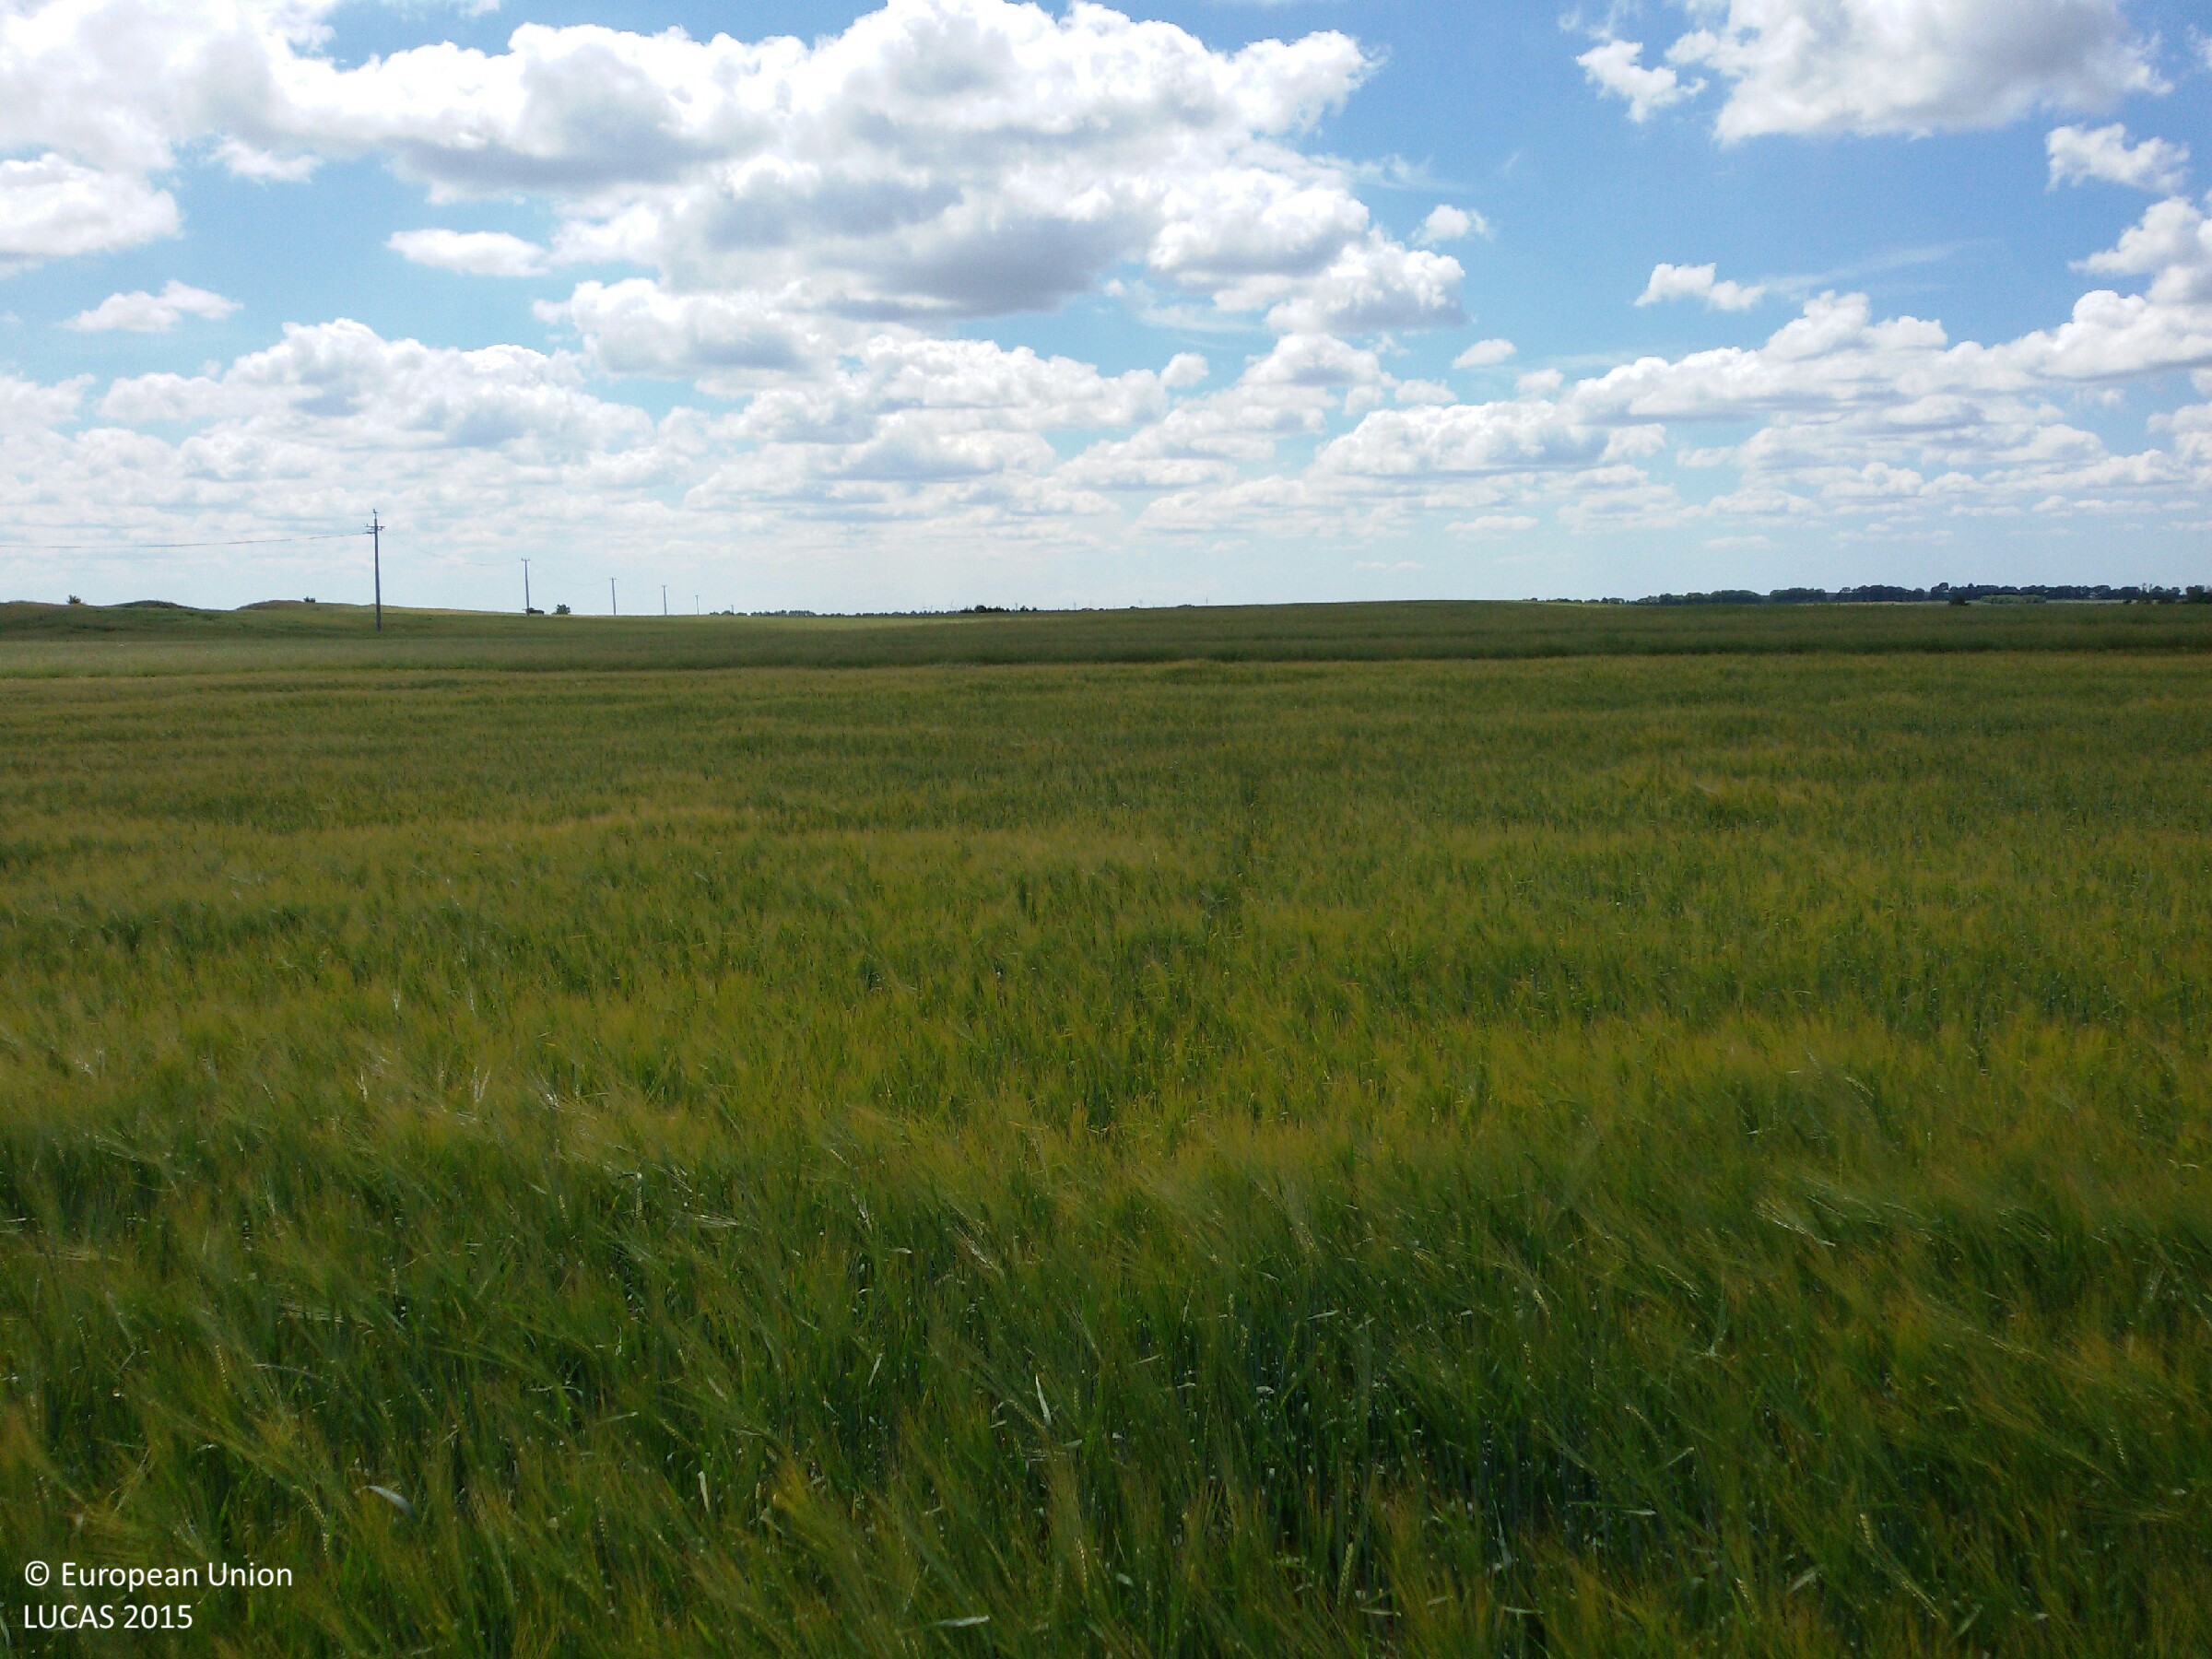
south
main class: Cropland
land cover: Barley
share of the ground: > 75 %
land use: Agriculture (excluding fallow land and kitchen gardens)
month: July
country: PL
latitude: 53.4113
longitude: 20.1277
